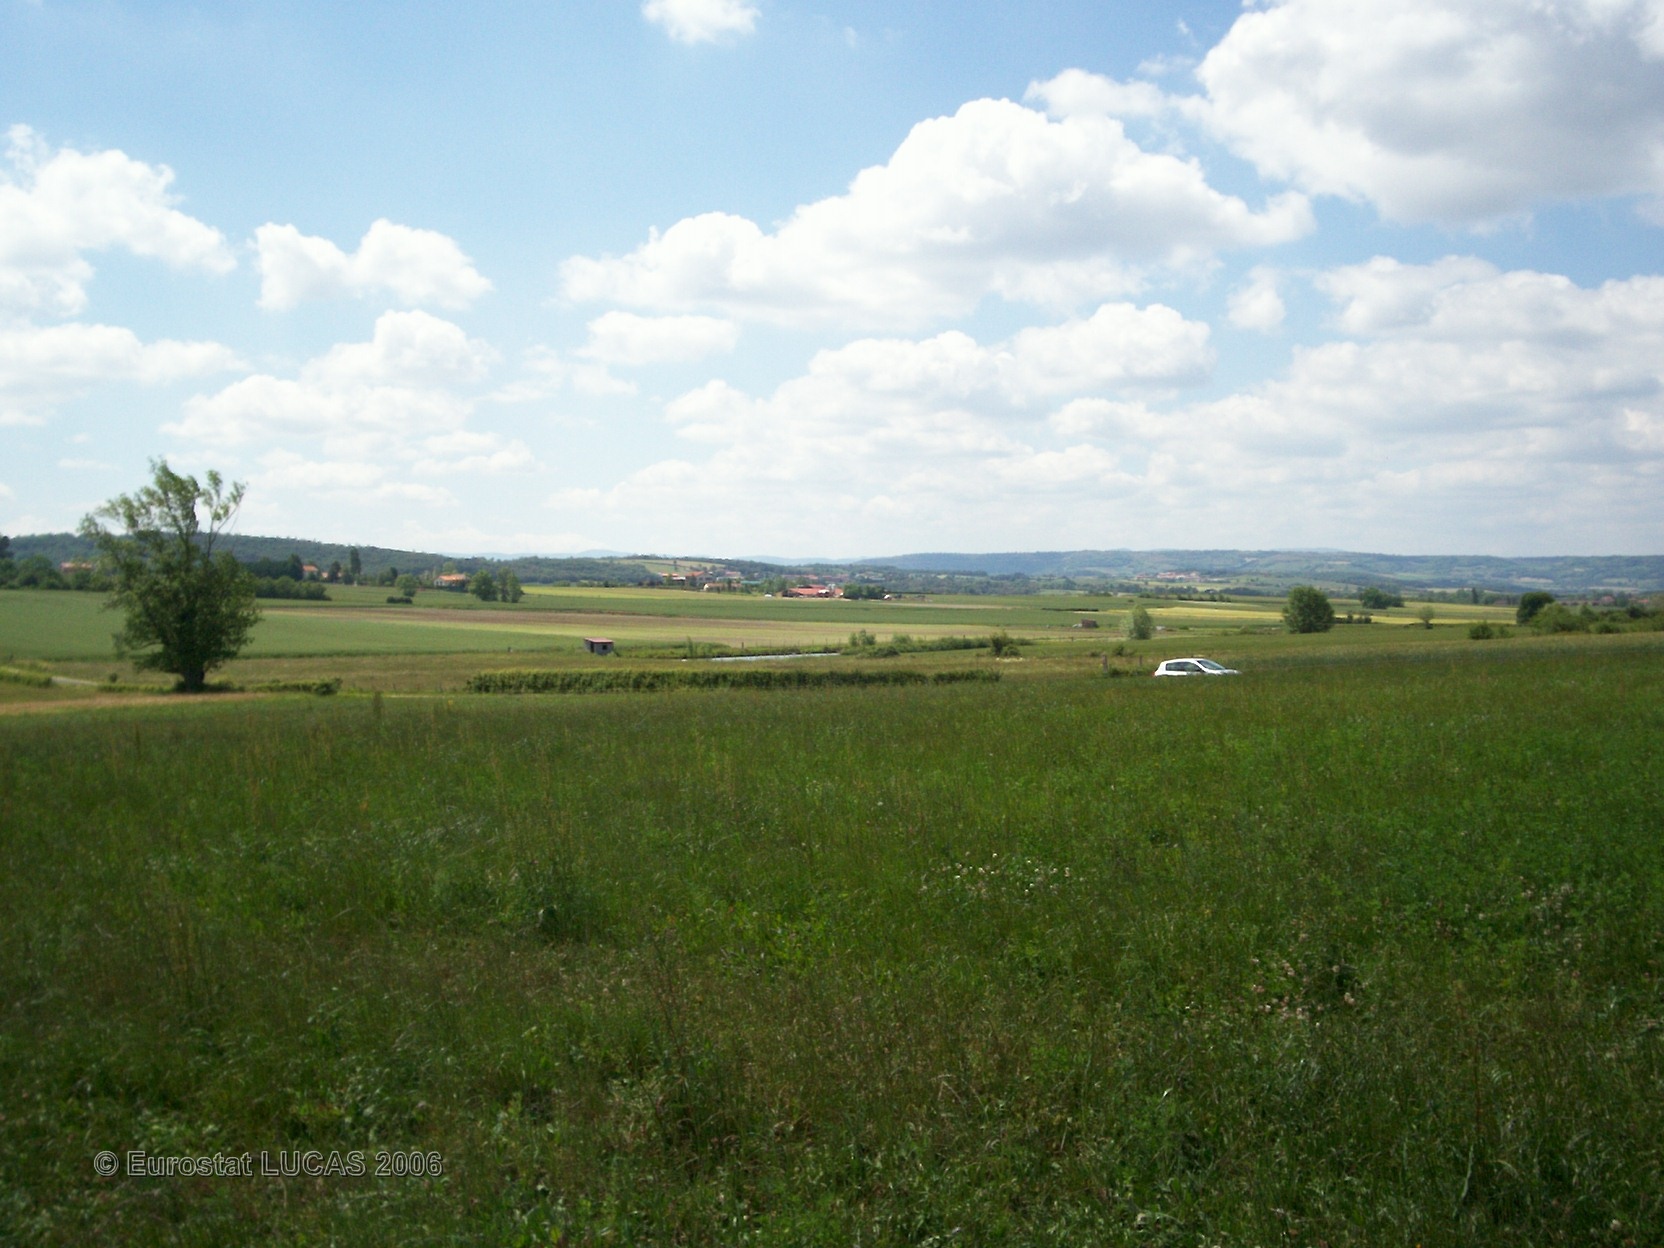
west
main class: Grassland
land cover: Grassland without tree/shrub cover
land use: Agriculture (excluding fallow land and kitchen gardens)
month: June
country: FR
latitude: 45.3474
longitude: 3.3267
